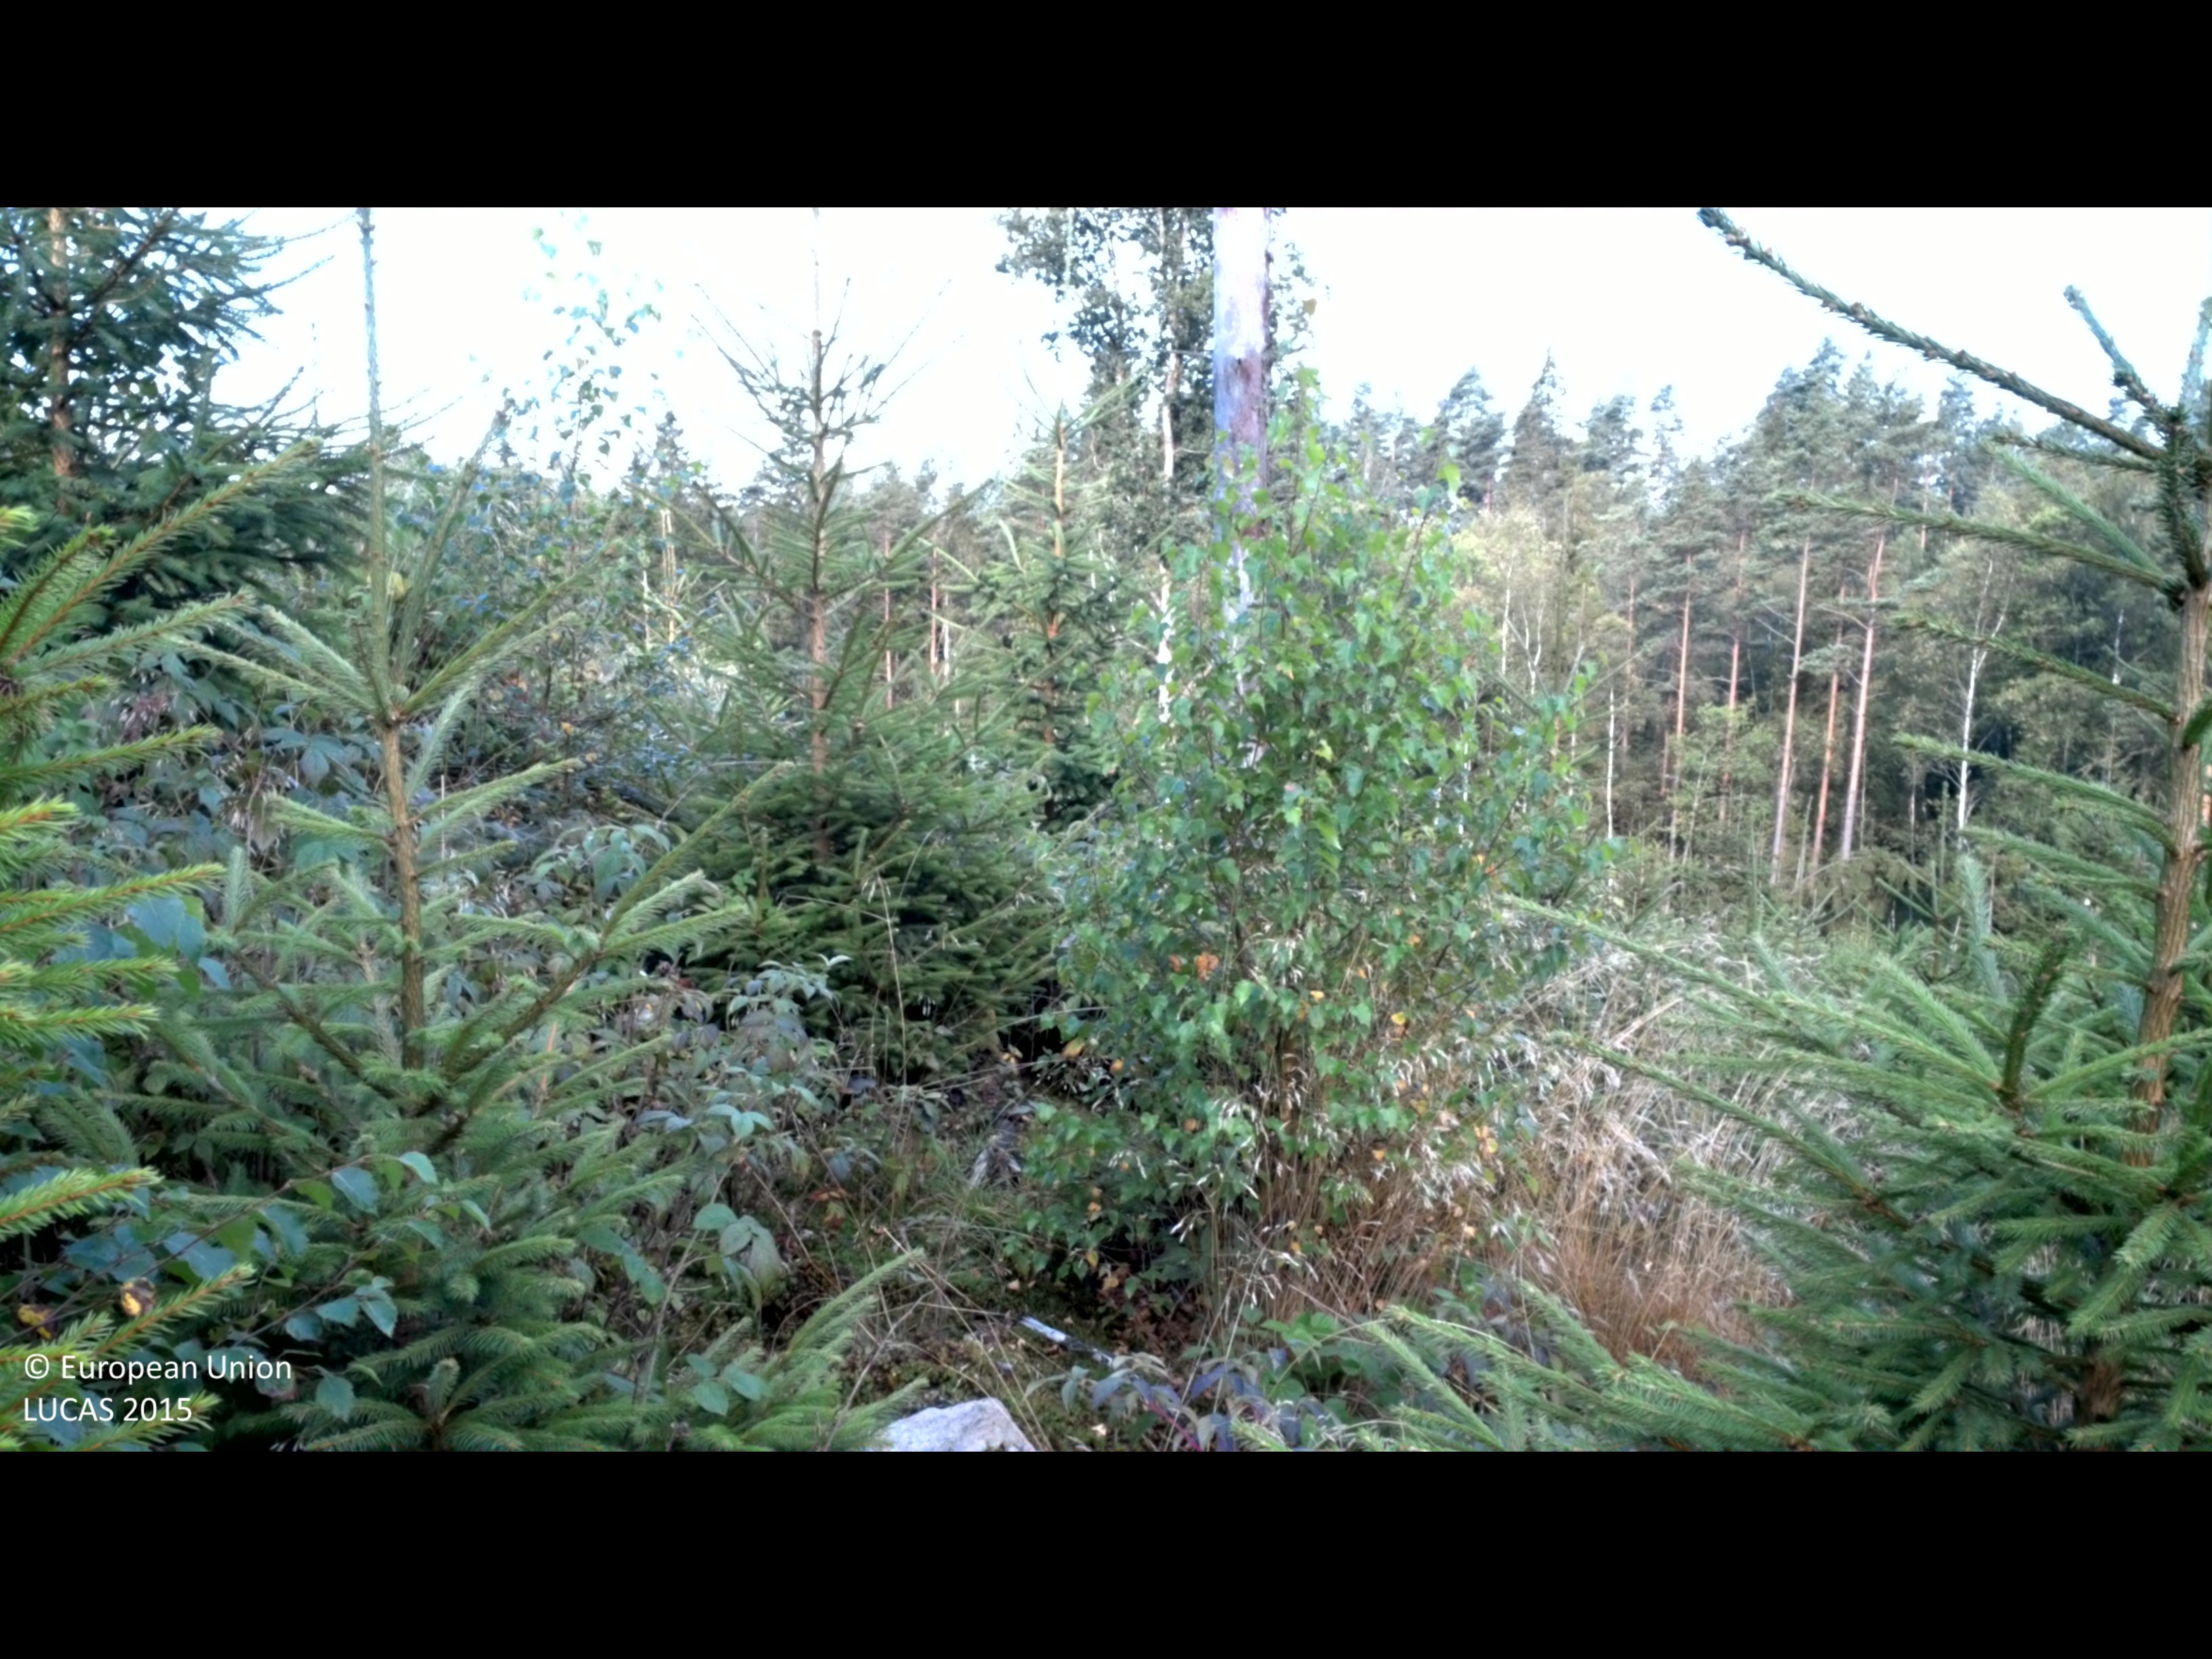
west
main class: Woodland
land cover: Spruce dominated mixed woodland
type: boreal forest
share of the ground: 50 - 75 %
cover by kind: coniferous forest trees 45 %, shrubs 30 %, broadleaved forest trees 15 %, herbaceous plants 10 %
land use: Forestry
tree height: < 5 m
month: August
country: SE
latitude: 56.7951
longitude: 13.2221
